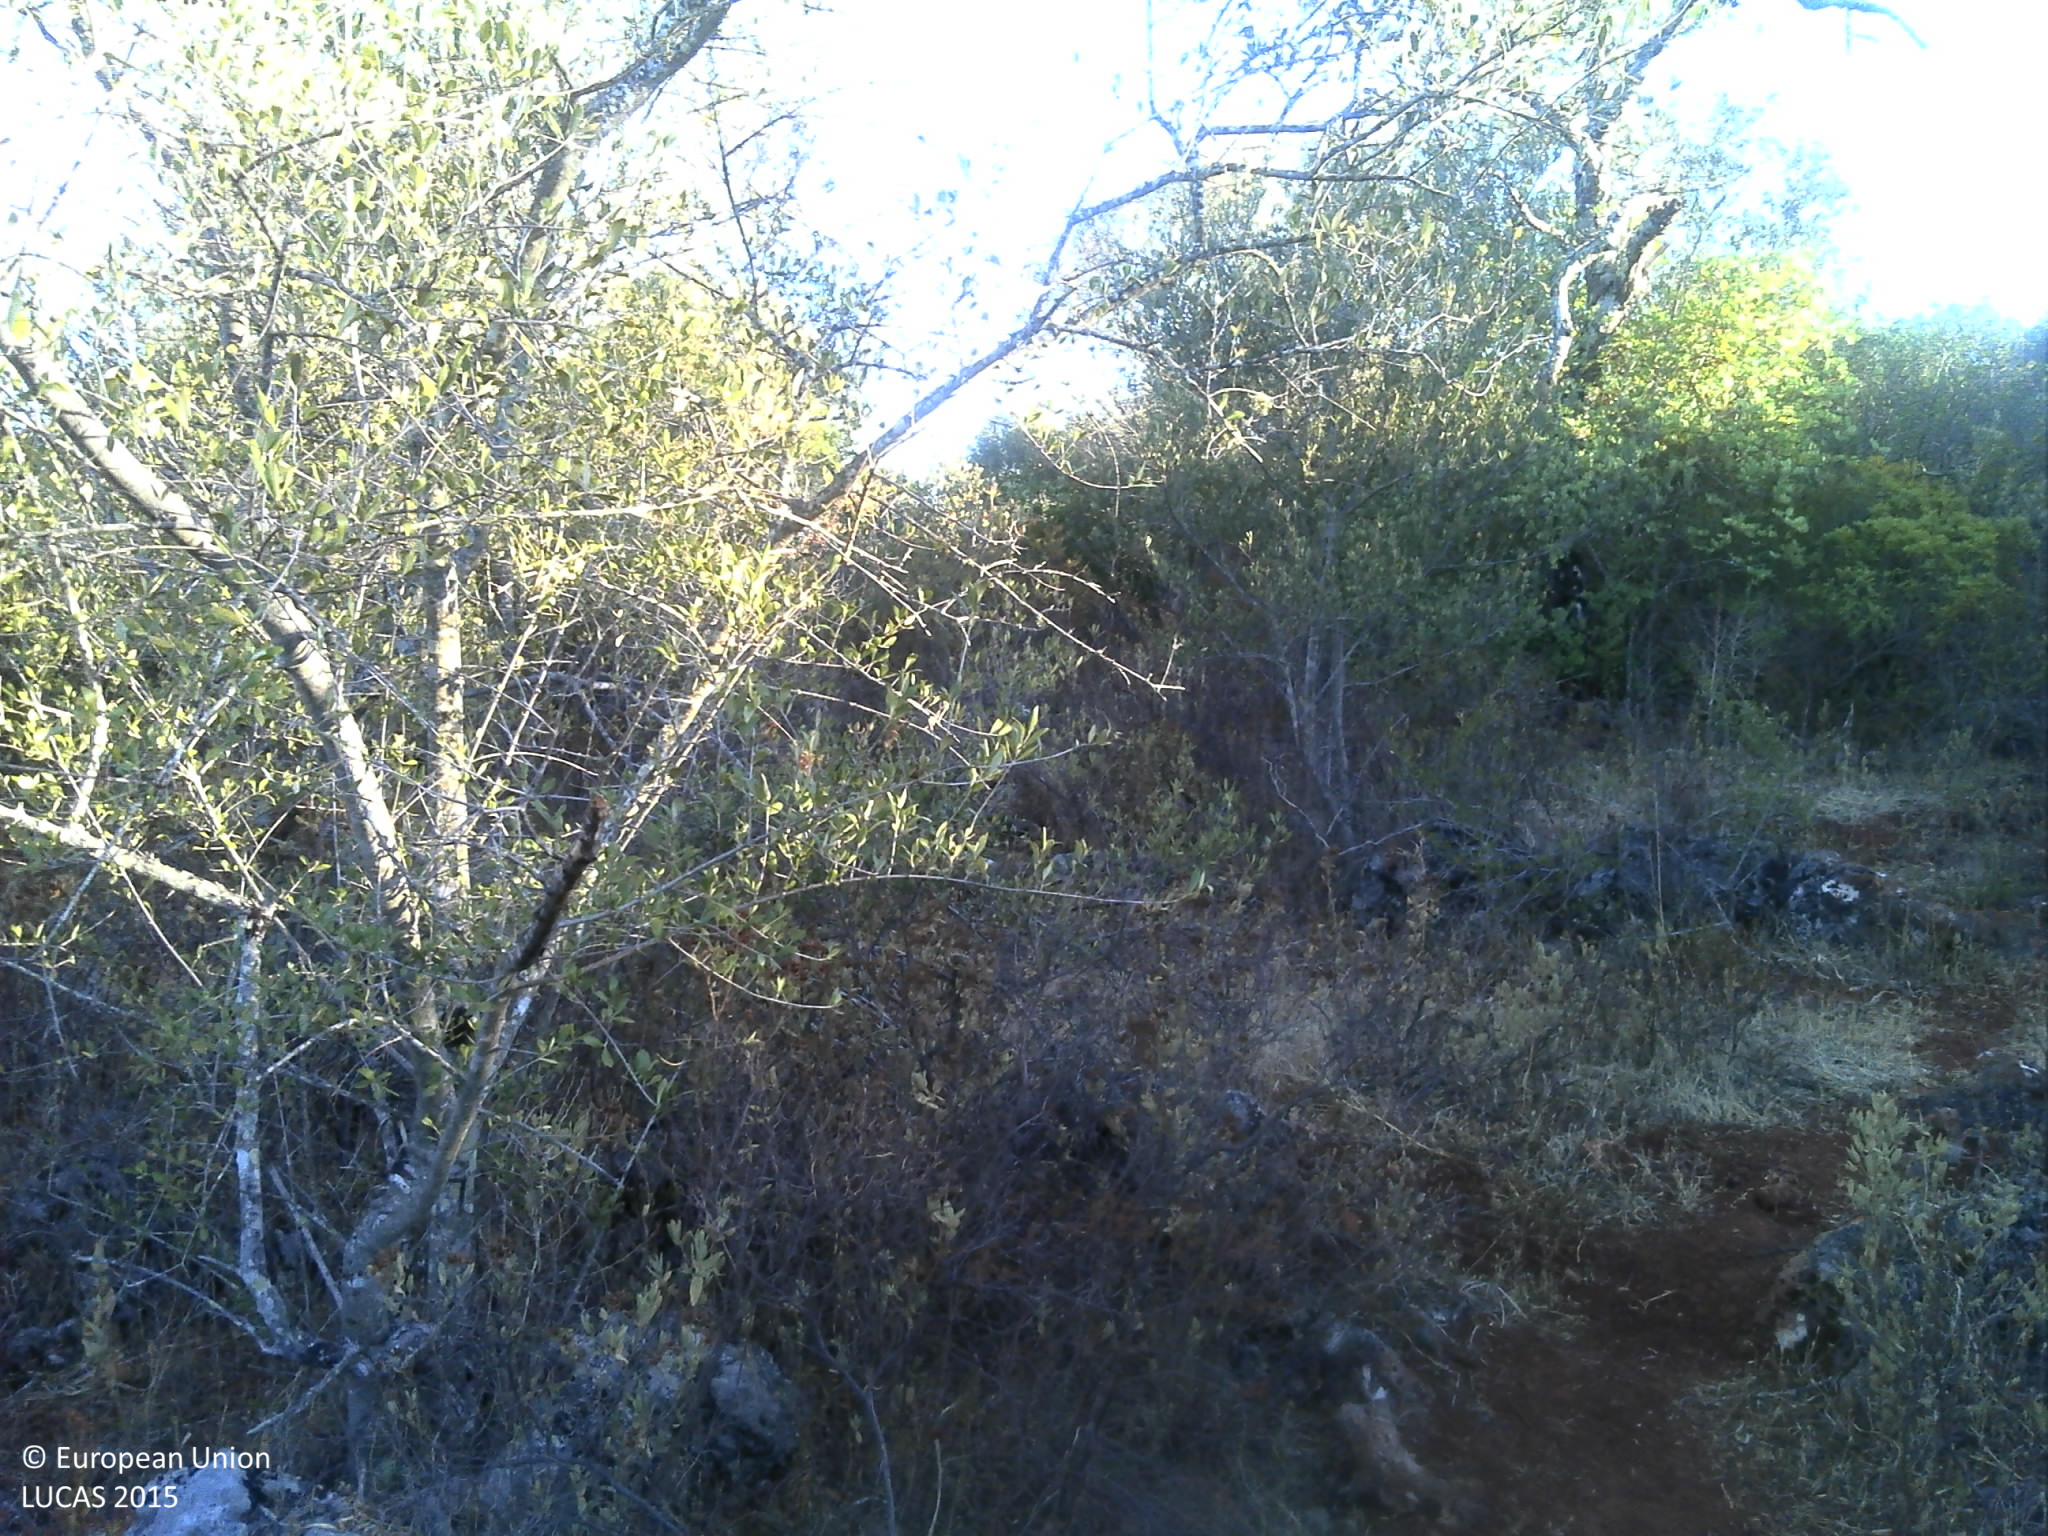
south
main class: Shrubland
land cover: Shrubland with sparse tree cover
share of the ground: 50 - 75 %
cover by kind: shrubs 50 %, unconsolidated bare surface 40 %, broadleaved forest trees 5 %, herbaceous plants 5 %
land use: Abandoned areas
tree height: < 5 m
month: September
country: PT
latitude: 37.2299
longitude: -8.1303
